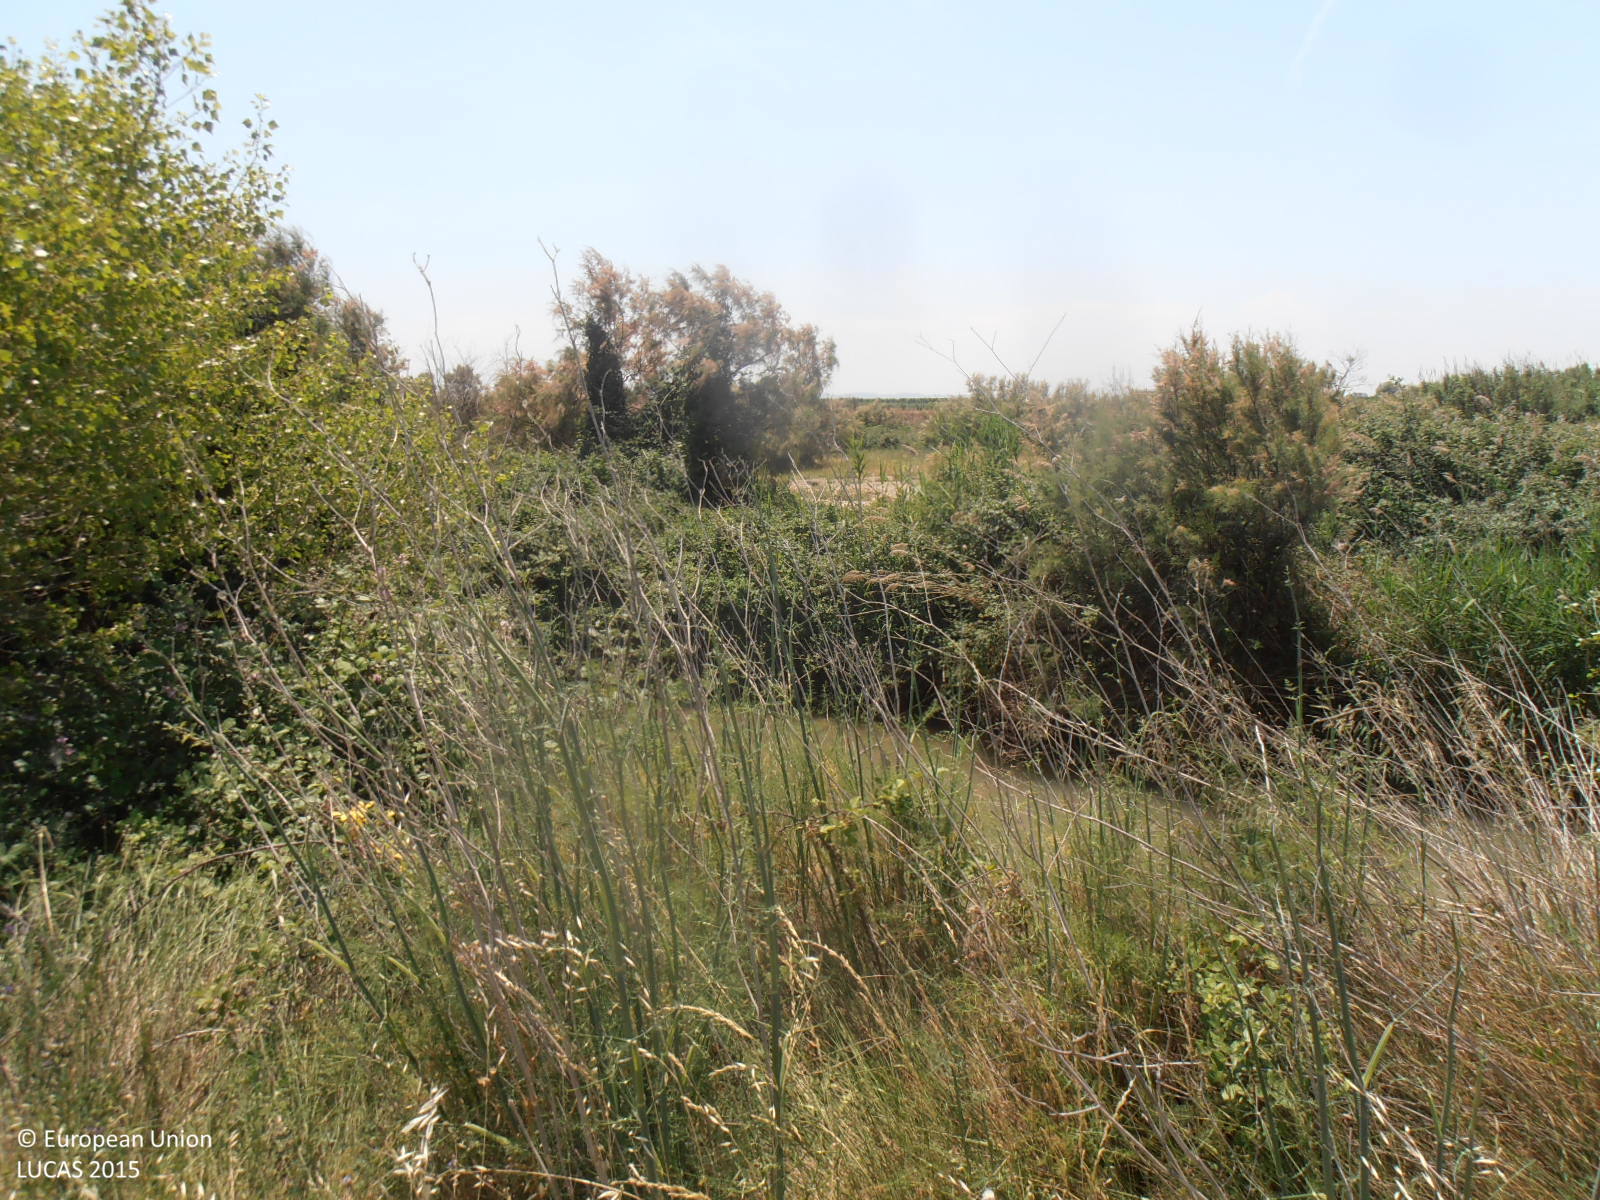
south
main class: Cropland
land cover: Durum wheat
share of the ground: > 75 %
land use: Agriculture (excluding fallow land and kitchen gardens)
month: June
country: ES
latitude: 41.7710
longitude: -1.0798
